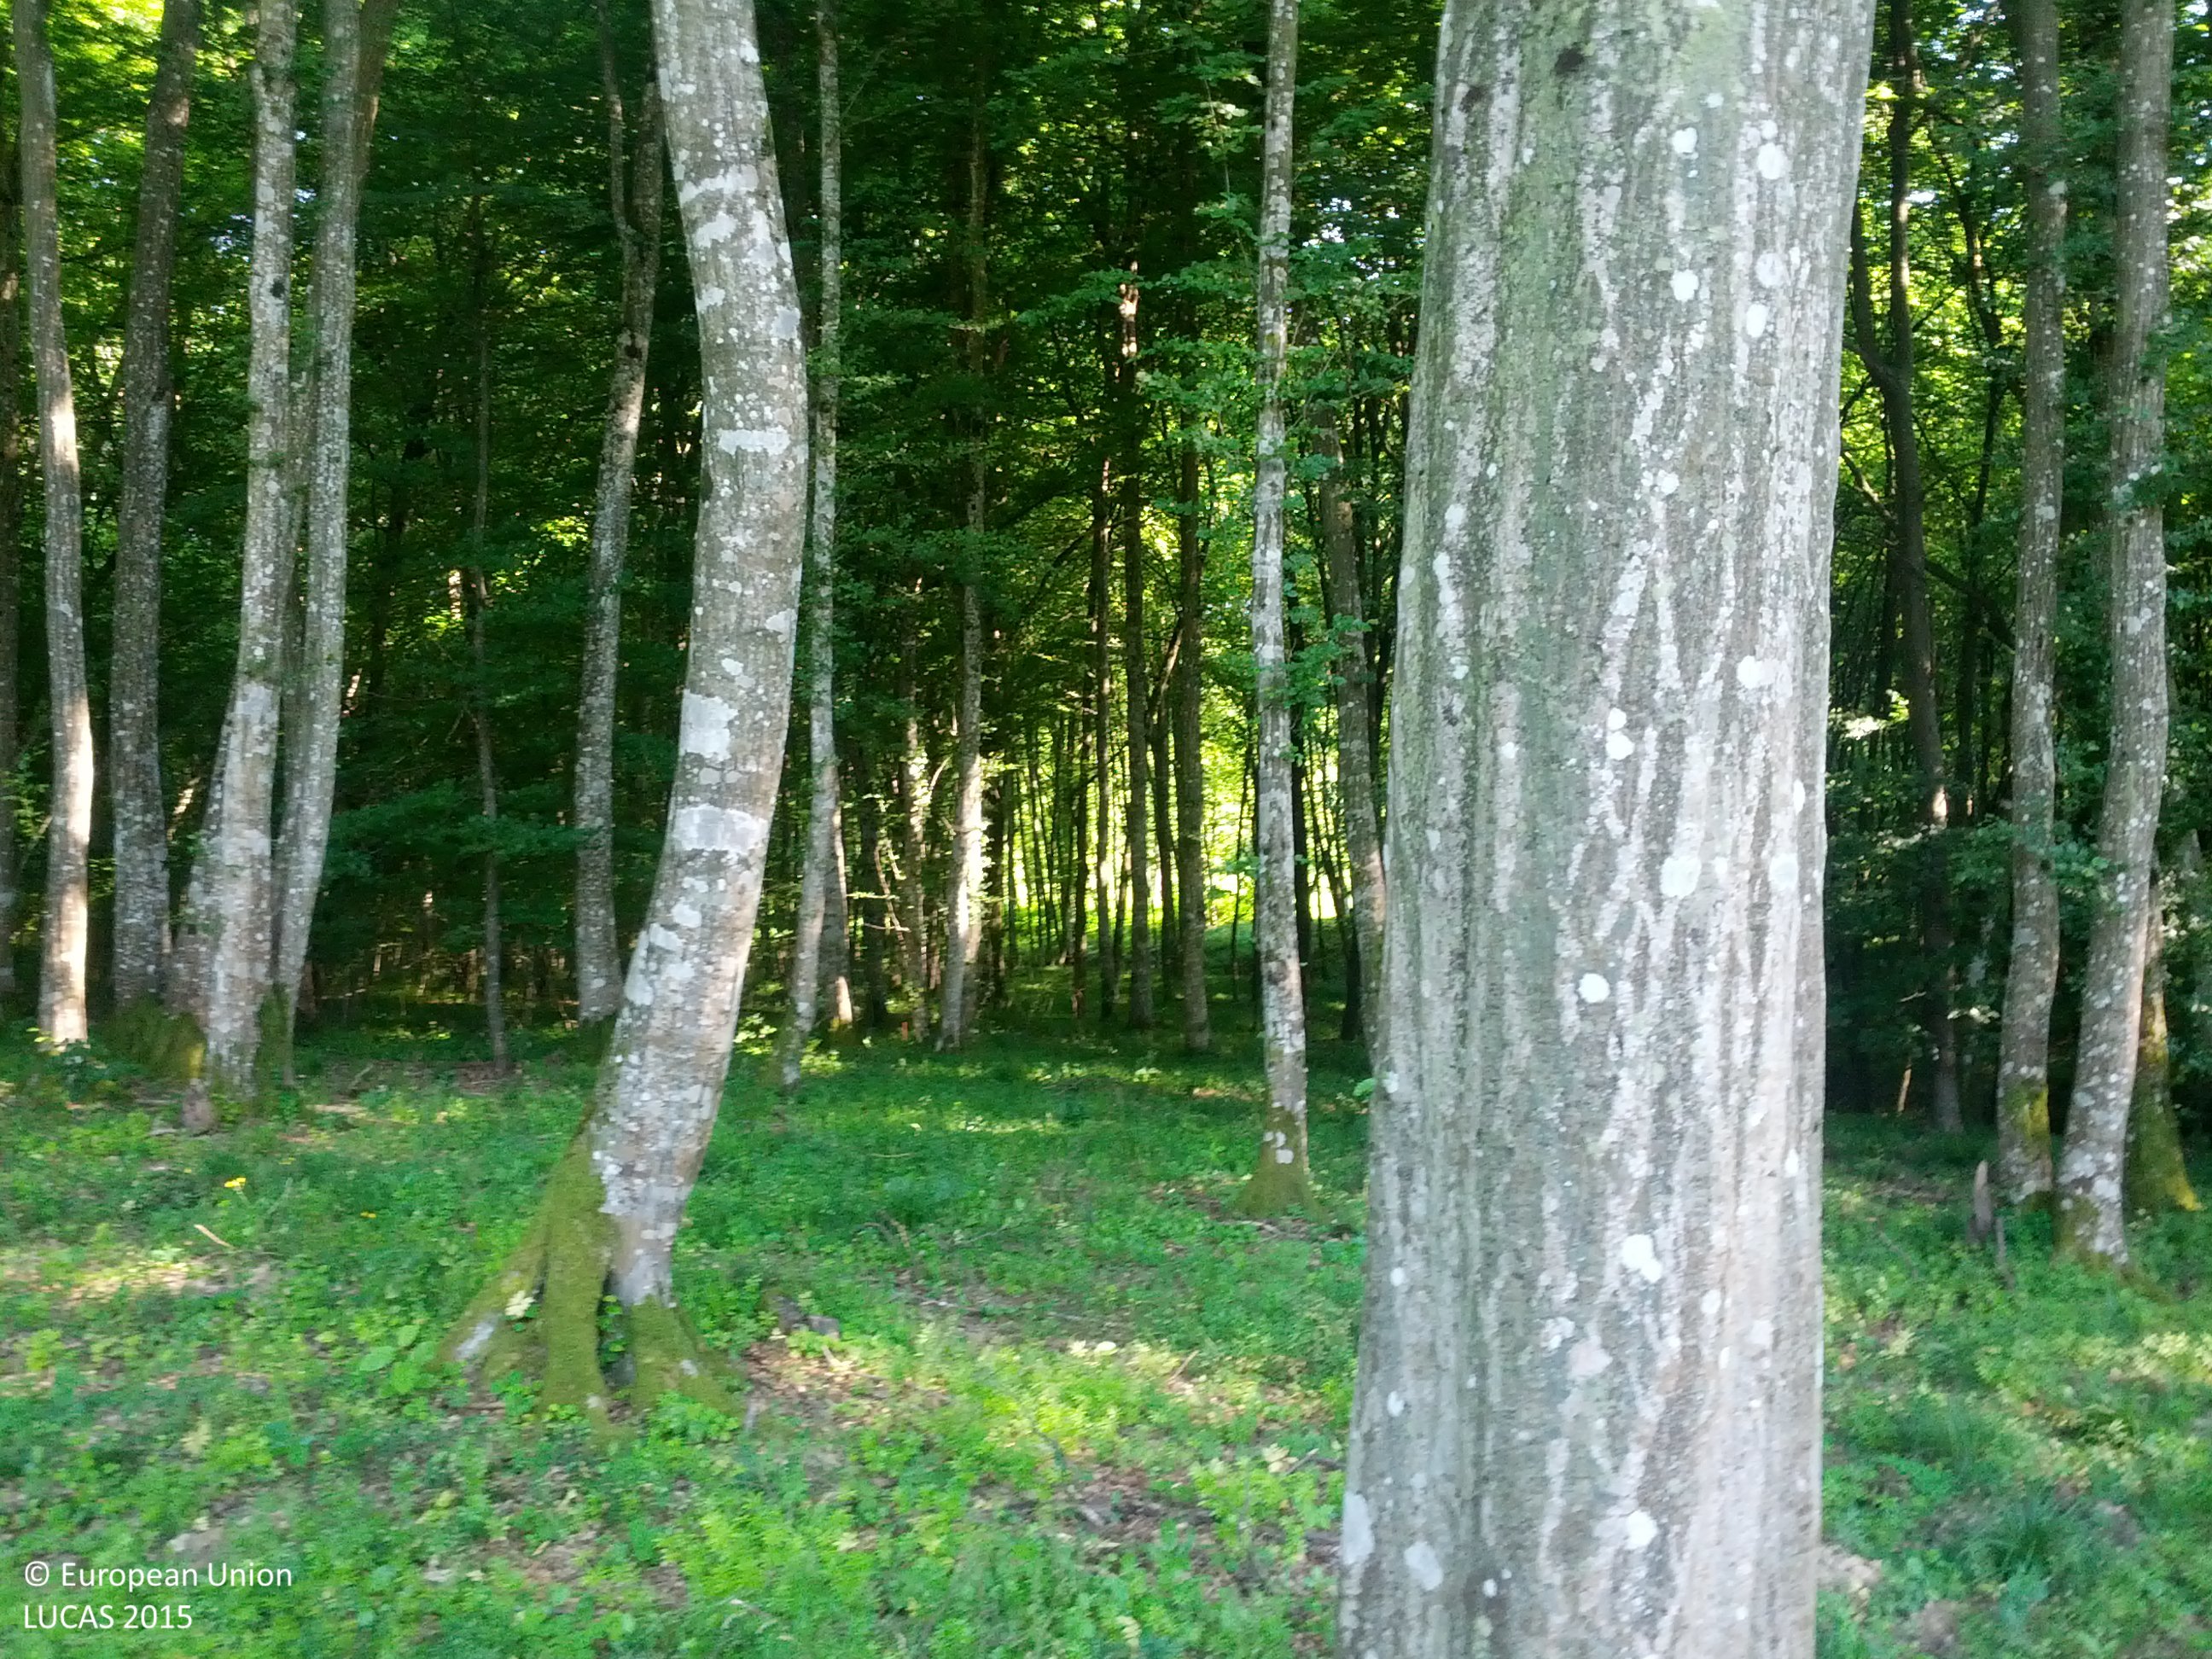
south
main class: Woodland
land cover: Broadleaved woodland
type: mountainous beech forest
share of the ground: > 75 %
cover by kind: broadleaved forest trees 80 %, herbaceous plants 15 %, coniferous forest trees 5 %
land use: Forestry
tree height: > 5 m
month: June
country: AT
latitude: 47.0275
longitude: 16.3838
